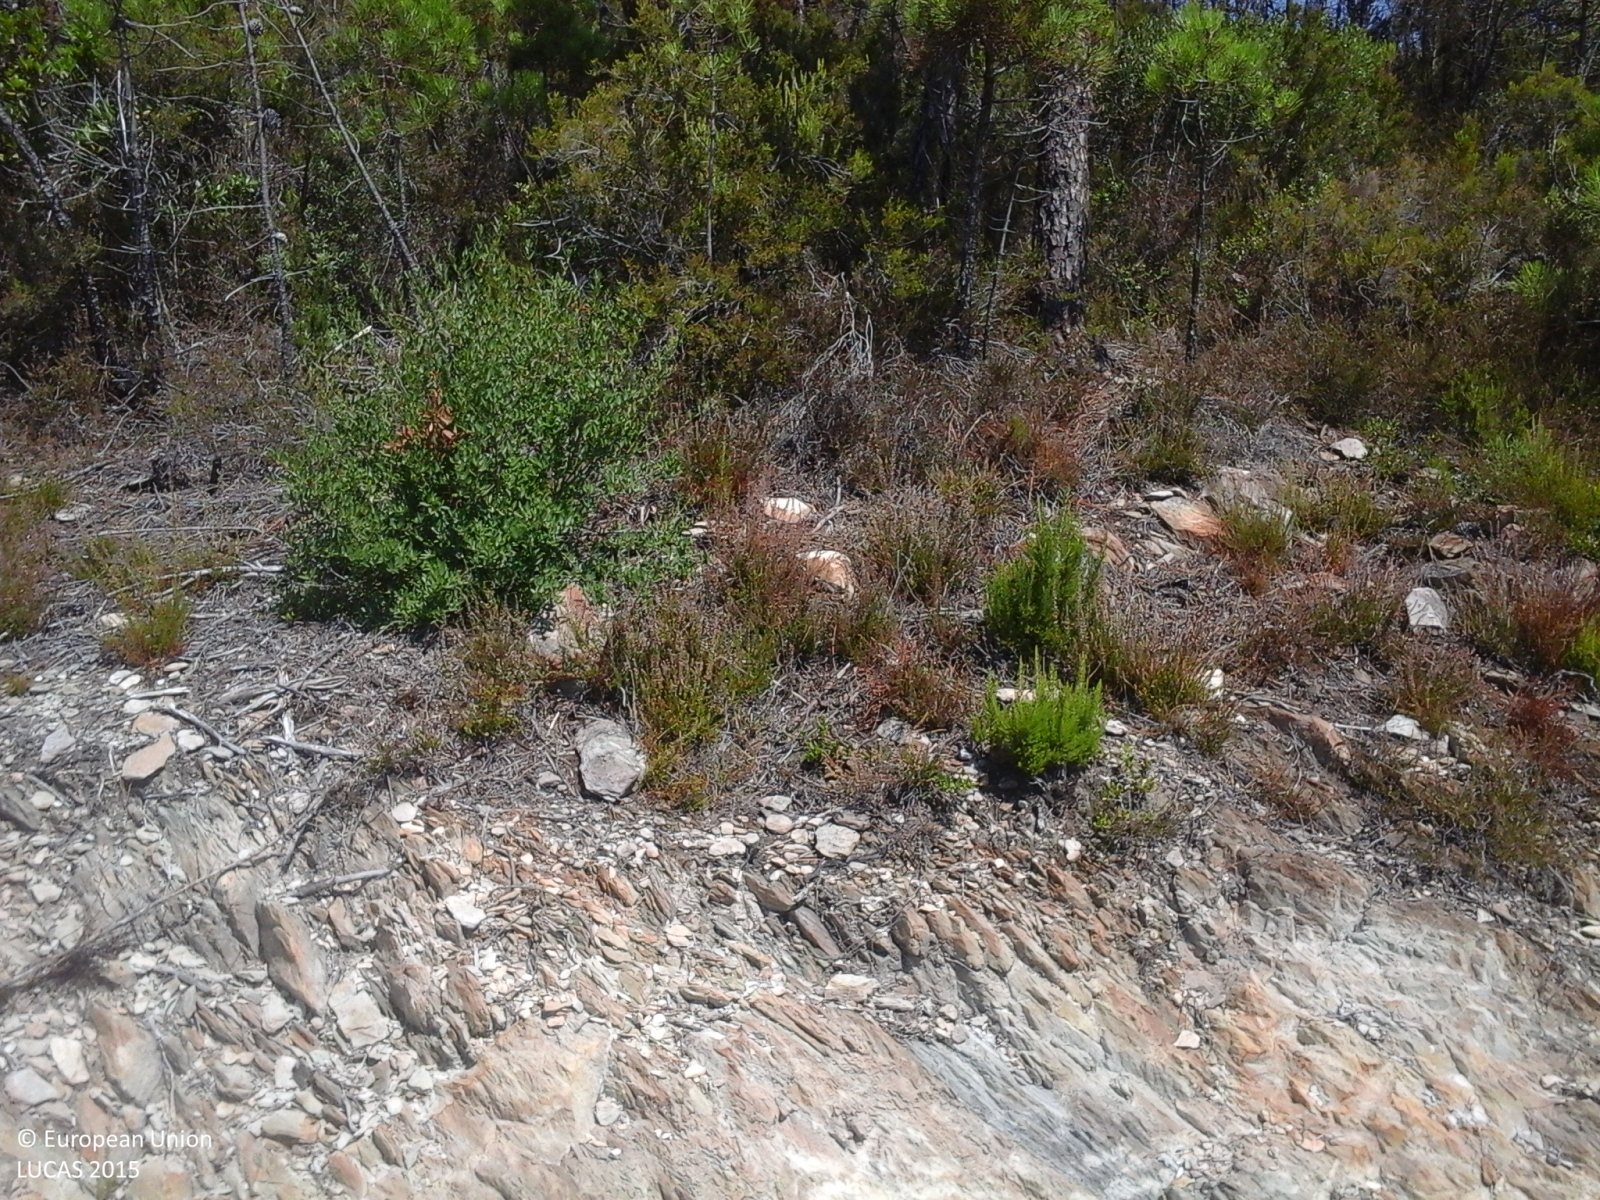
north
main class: Woodland
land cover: Pine dominated coniferous woodland
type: coniferous forest of the mediterranean region
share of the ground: > 75 %
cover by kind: coniferous forest trees 100 %
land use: Forestry
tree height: > 5 m
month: August
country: IT
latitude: 43.7175
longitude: 10.5818
